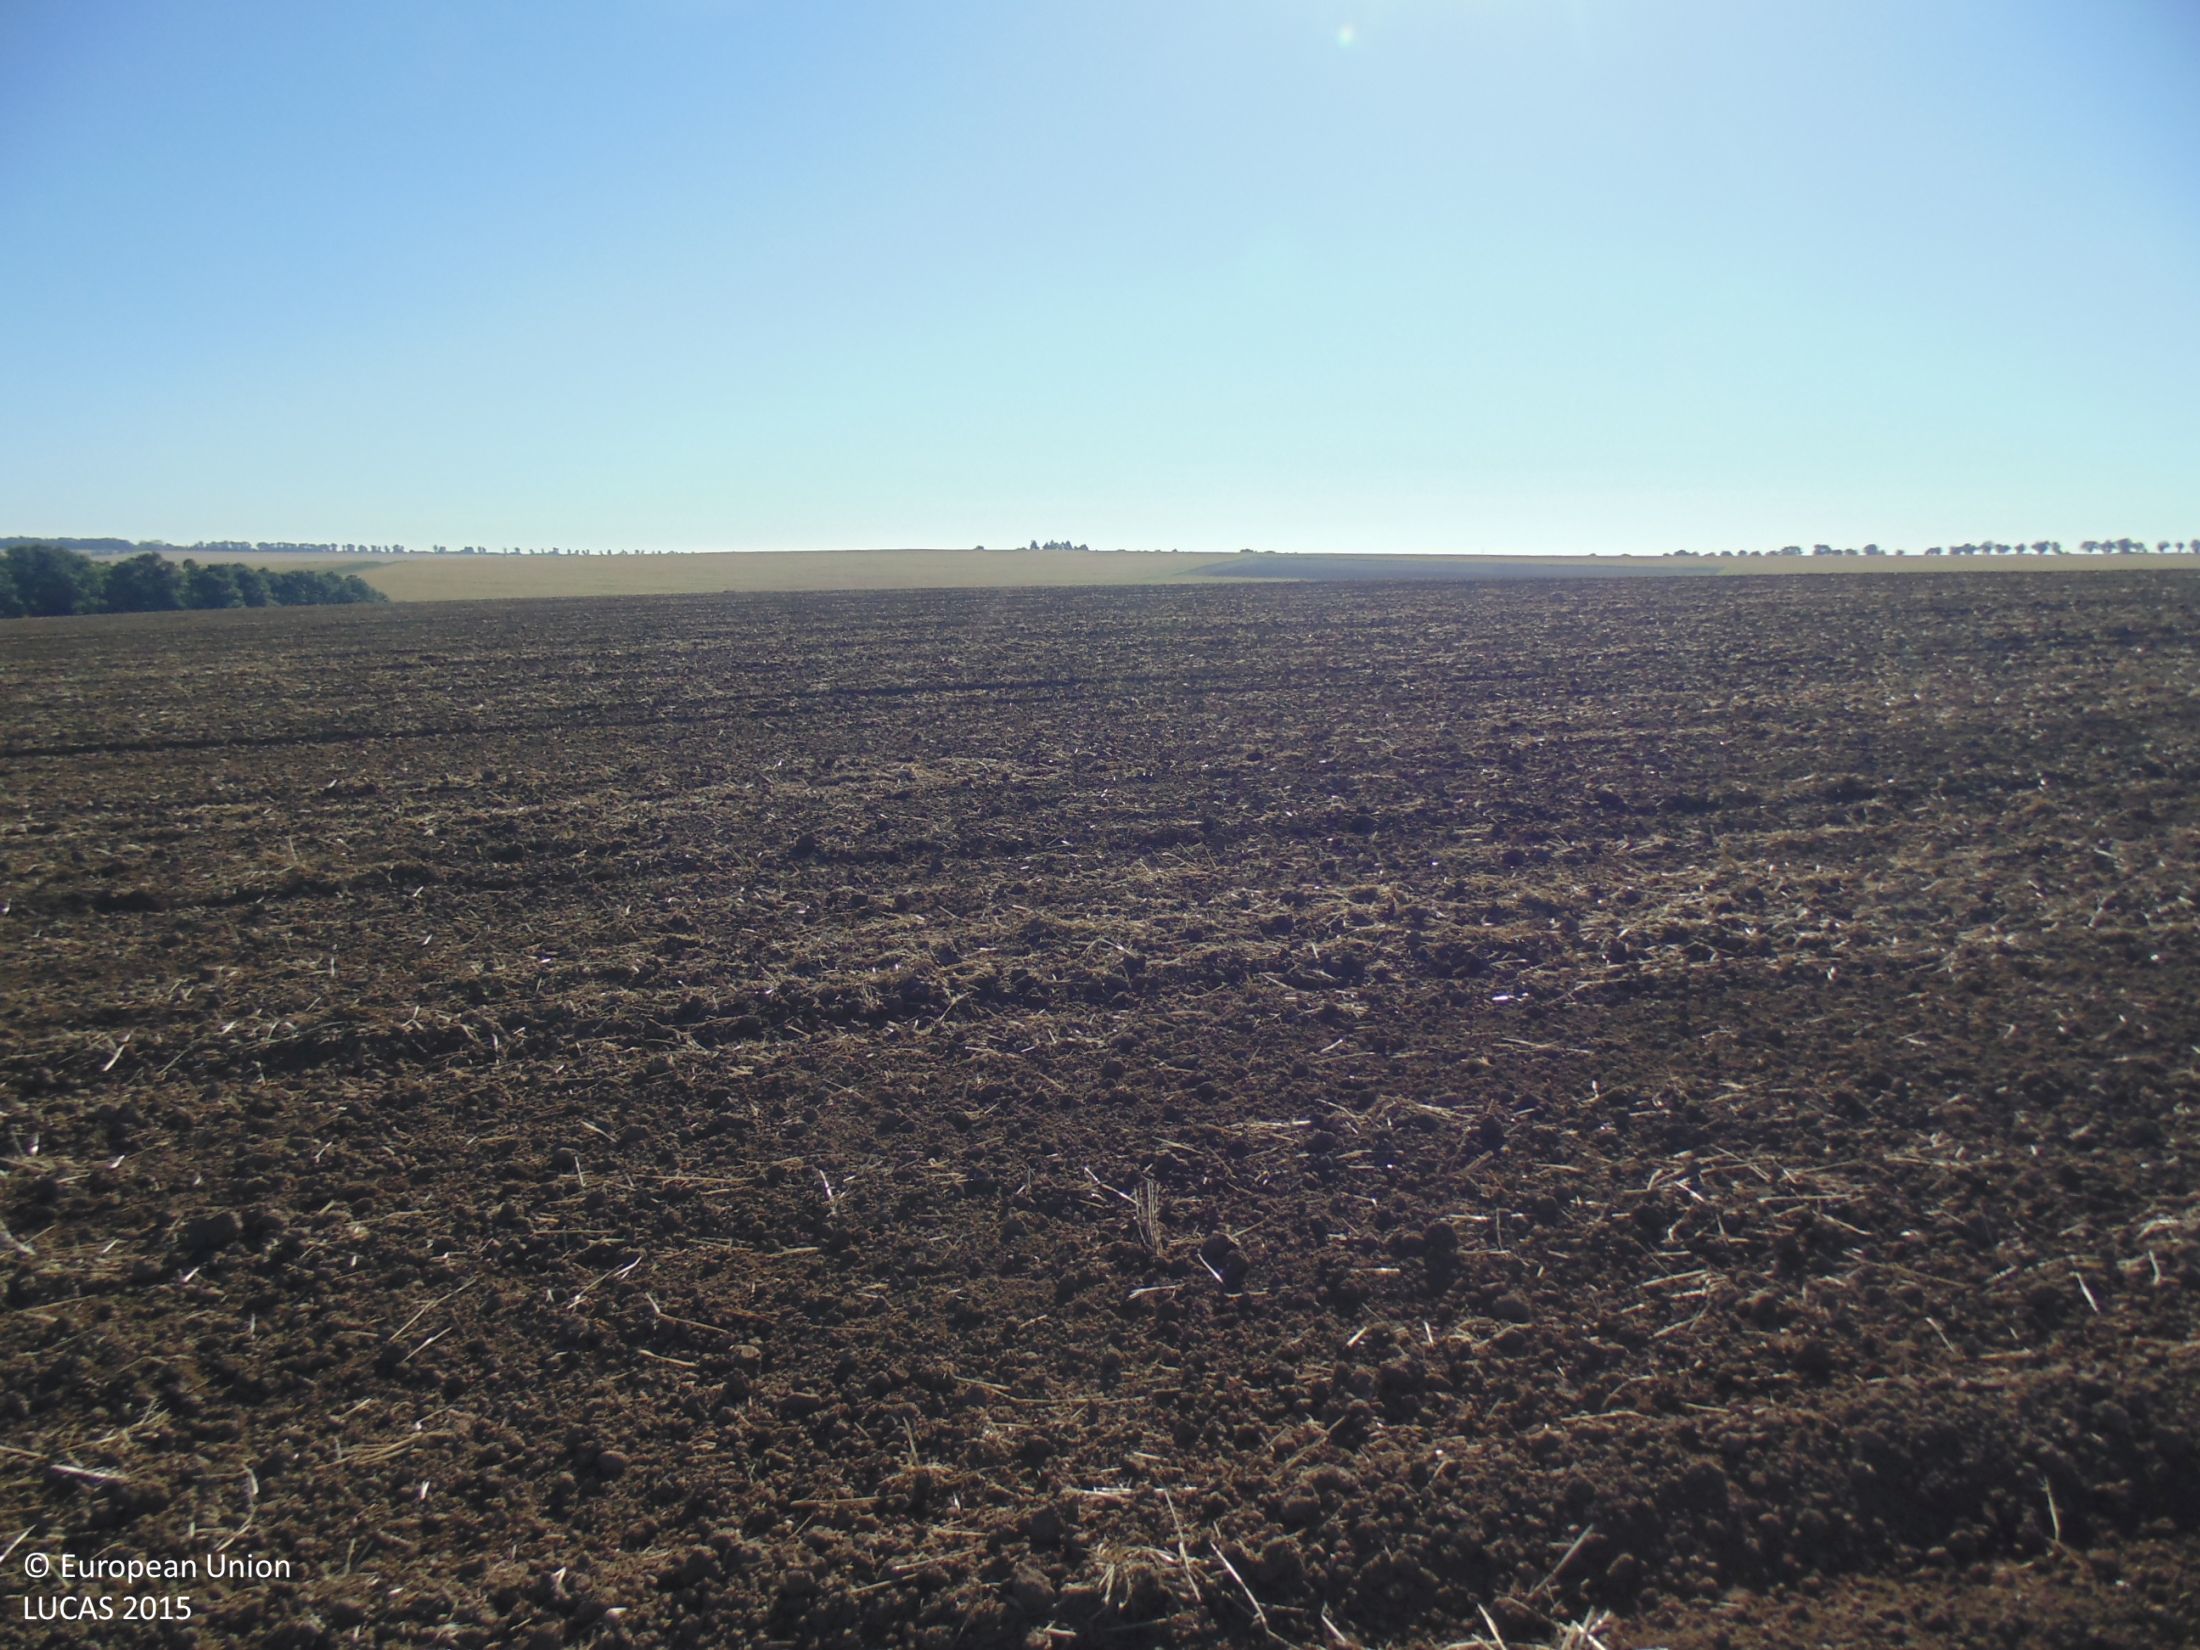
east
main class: Cropland
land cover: Common wheat
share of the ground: < 10 %
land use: Agriculture (excluding fallow land and kitchen gardens)
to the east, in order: Common wheat
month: September
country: BG
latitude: 43.7663
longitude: 27.3089
